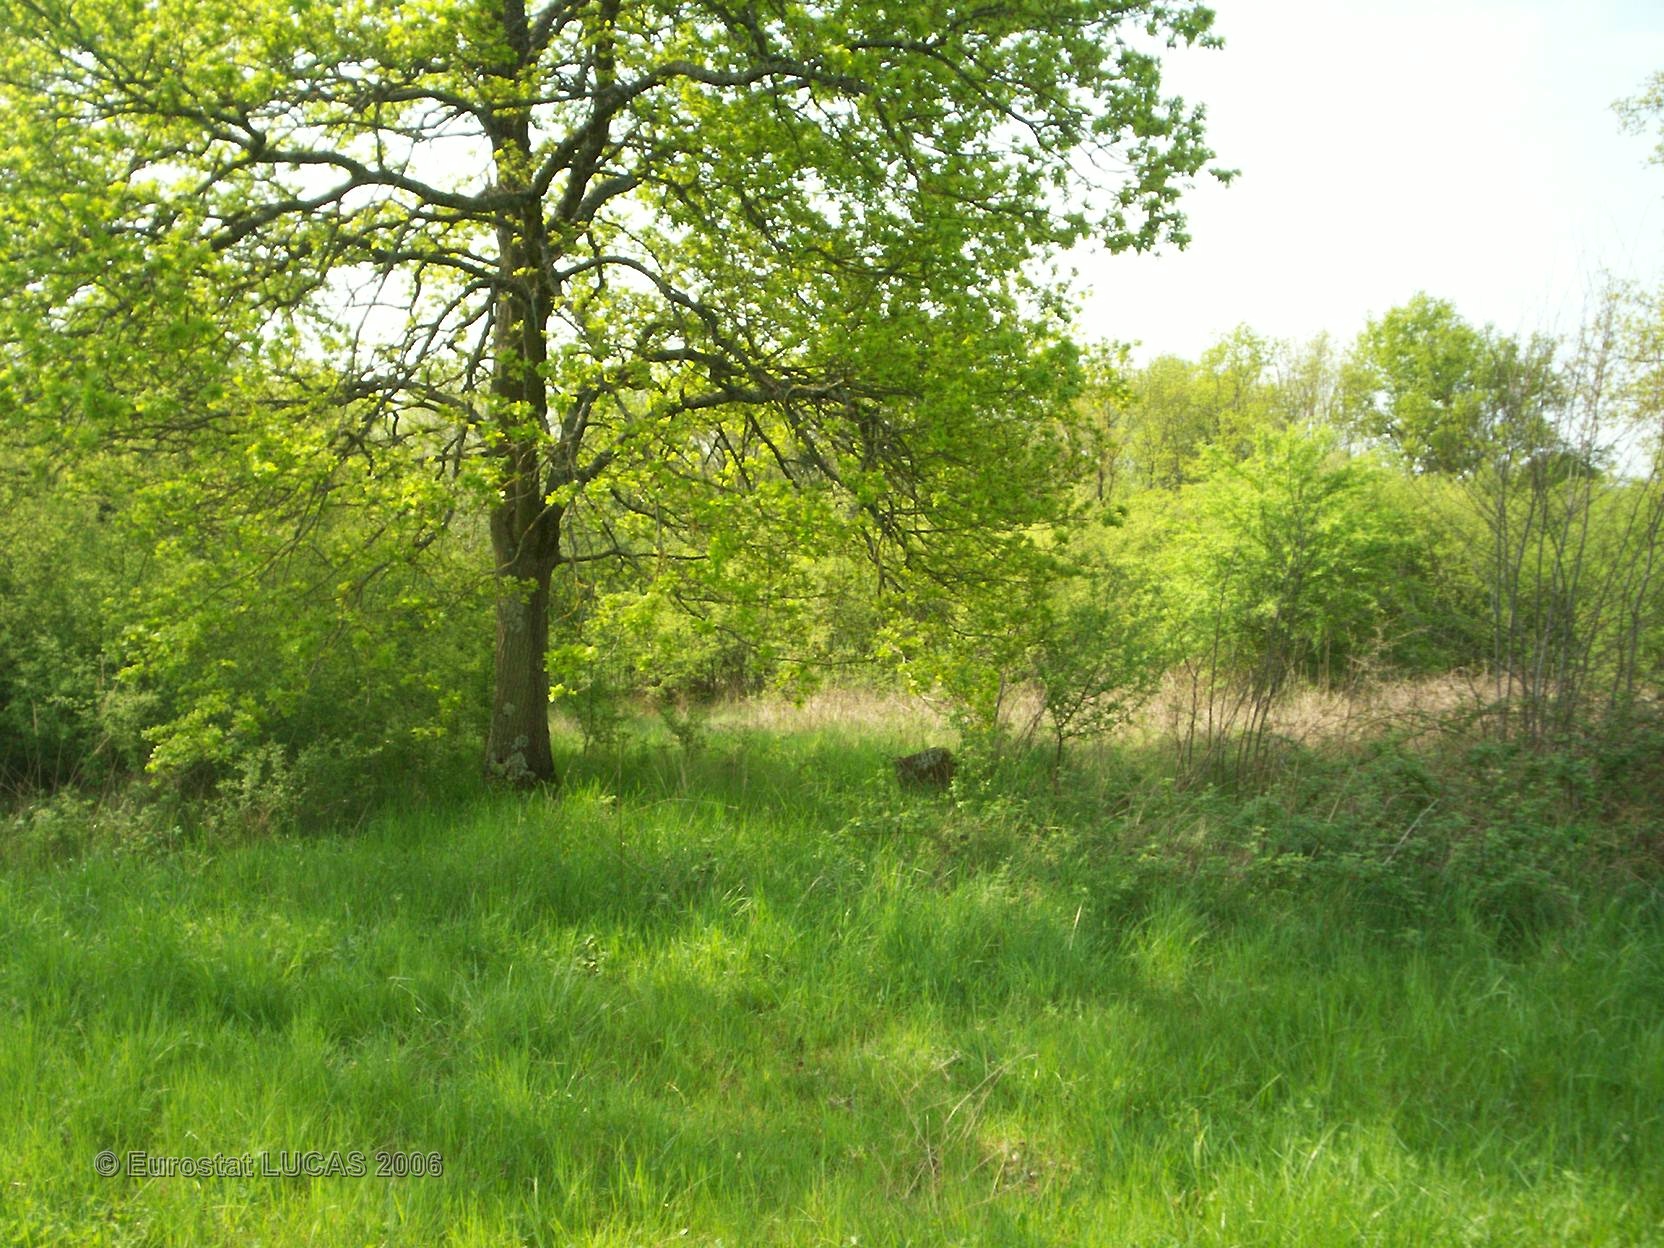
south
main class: Grassland
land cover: Grassland with sparse tree/shrub cover
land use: Agriculture (excluding fallow land and kitchen gardens)
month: May
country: FR
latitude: 48.0894
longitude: 2.9709
